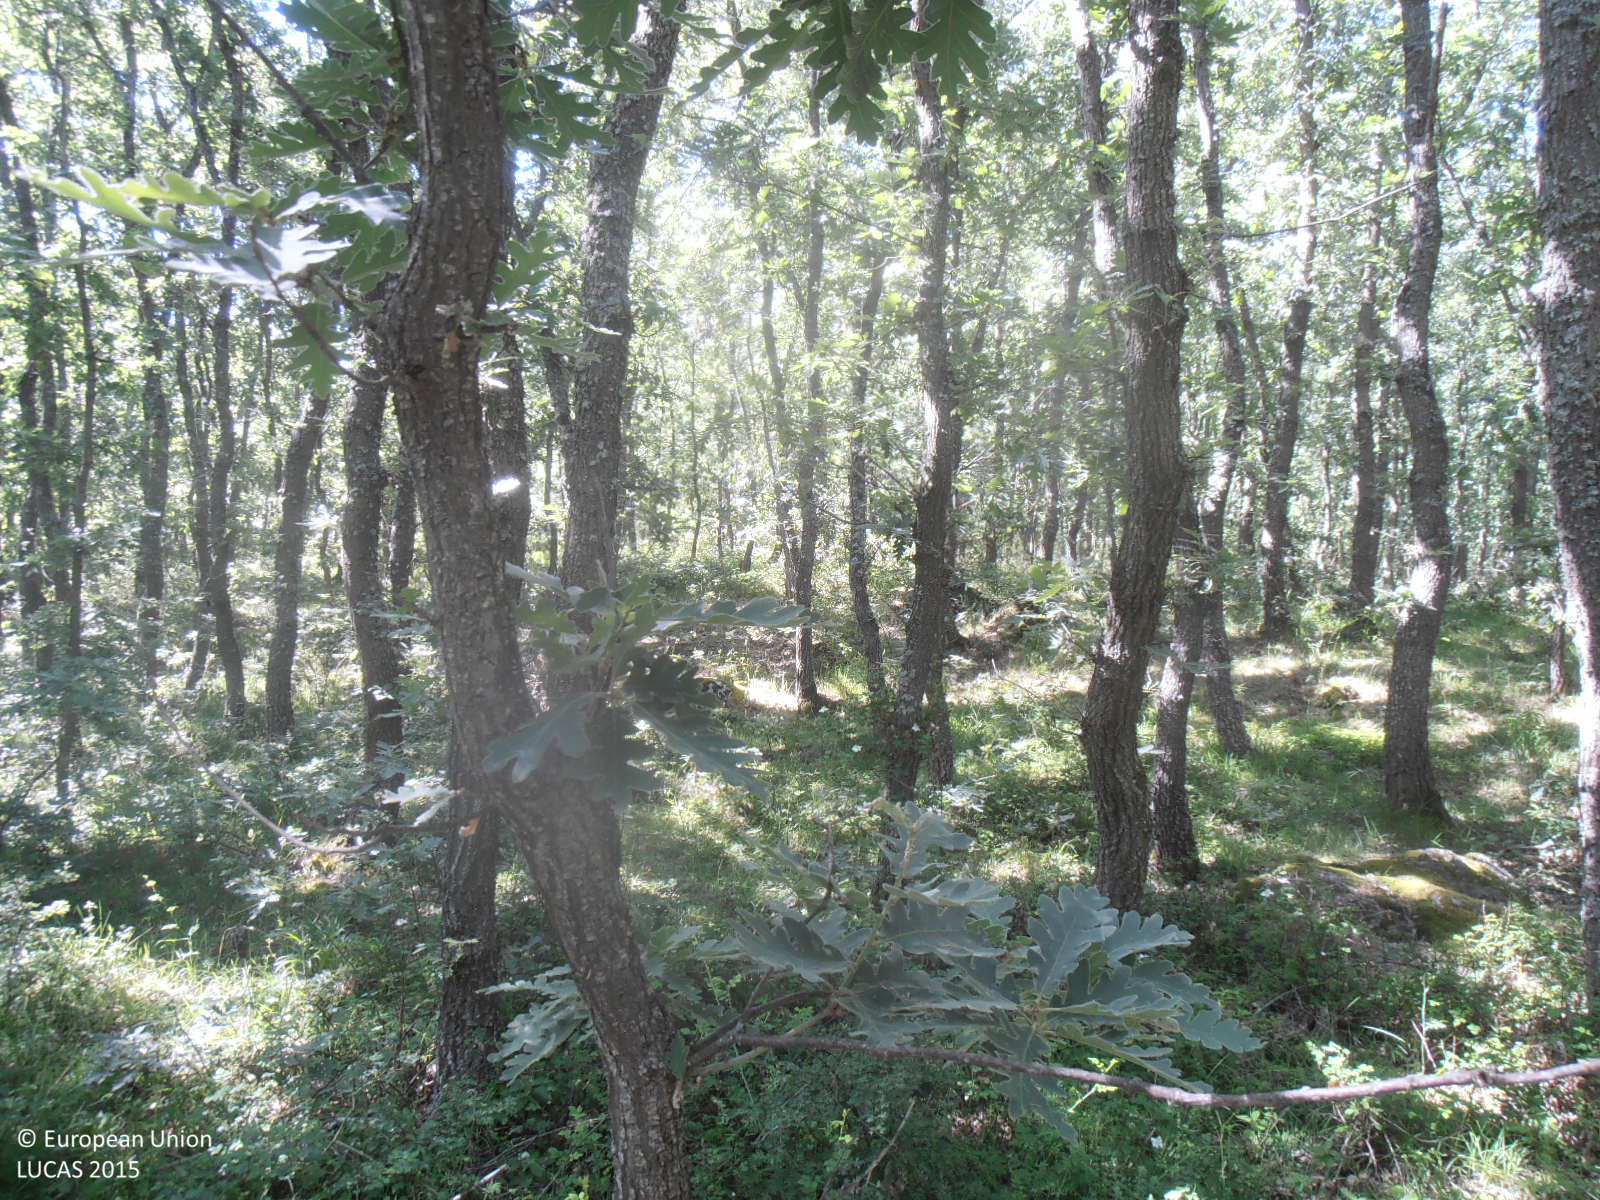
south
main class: Woodland
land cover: Broadleaved woodland
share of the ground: > 75 %
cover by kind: broadleaved forest trees 90 %, herbaceous plants 10 %
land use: Semi-natural and natural areas not in use
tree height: < 5 m
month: June
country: ES
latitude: 41.7584
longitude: -1.9758
